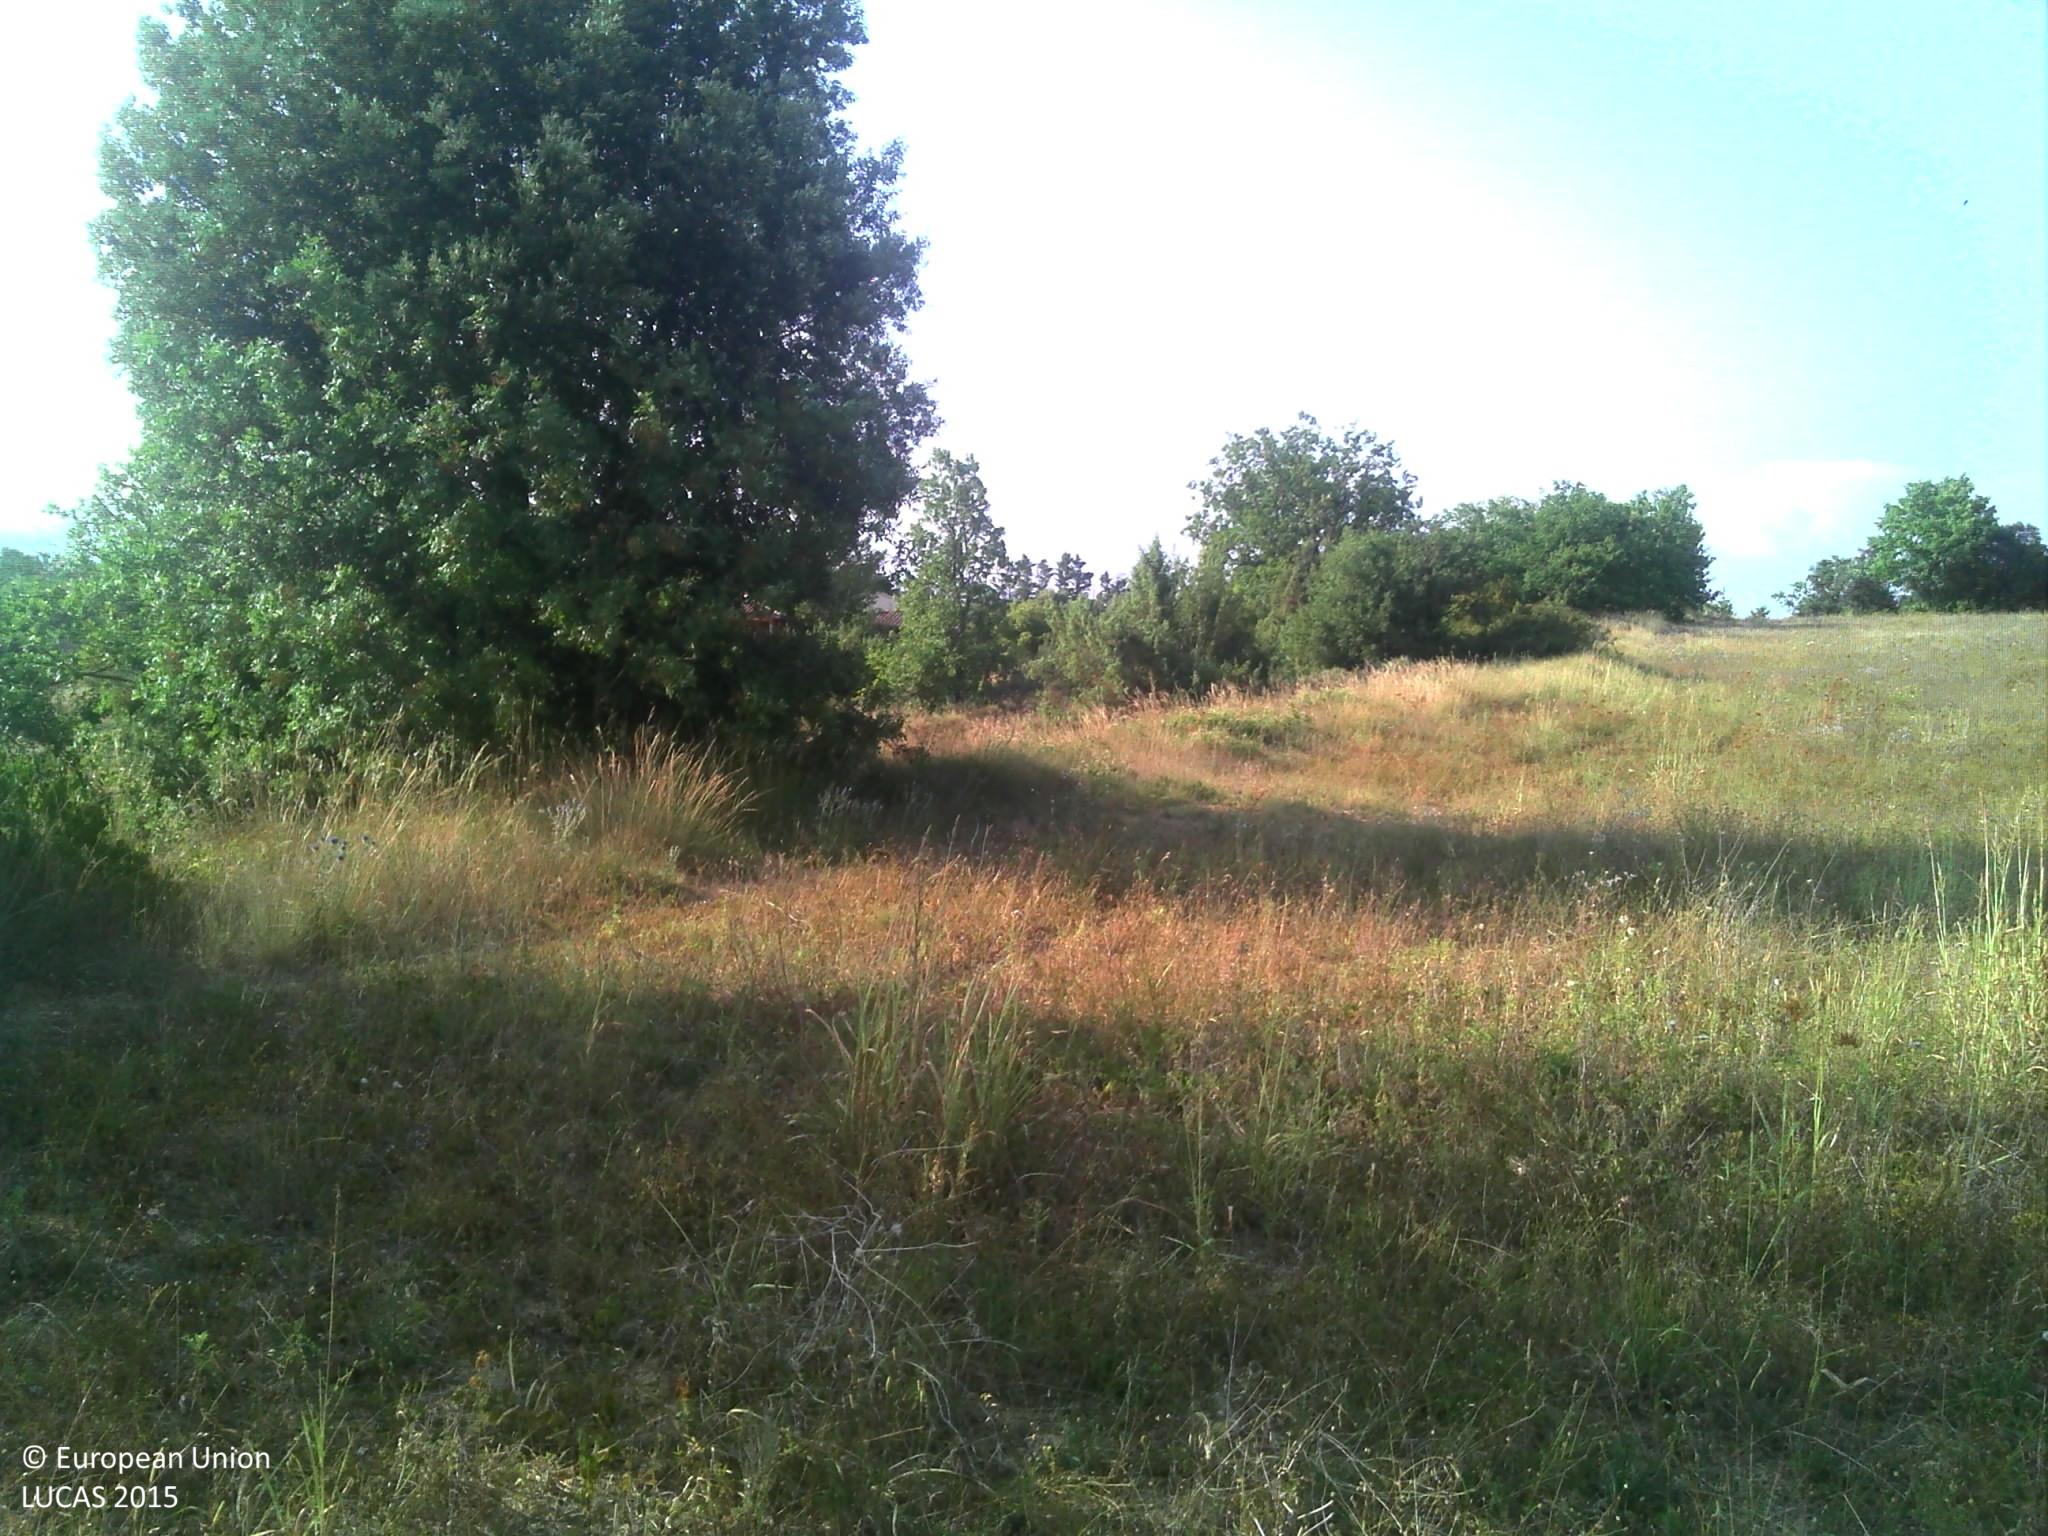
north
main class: Grassland
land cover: Grassland without tree/shrub cover
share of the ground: > 75 %
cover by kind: herbaceous plants 100 %
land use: Semi-natural and natural areas not in use
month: July
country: FR
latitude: 44.3731
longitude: 4.2716
